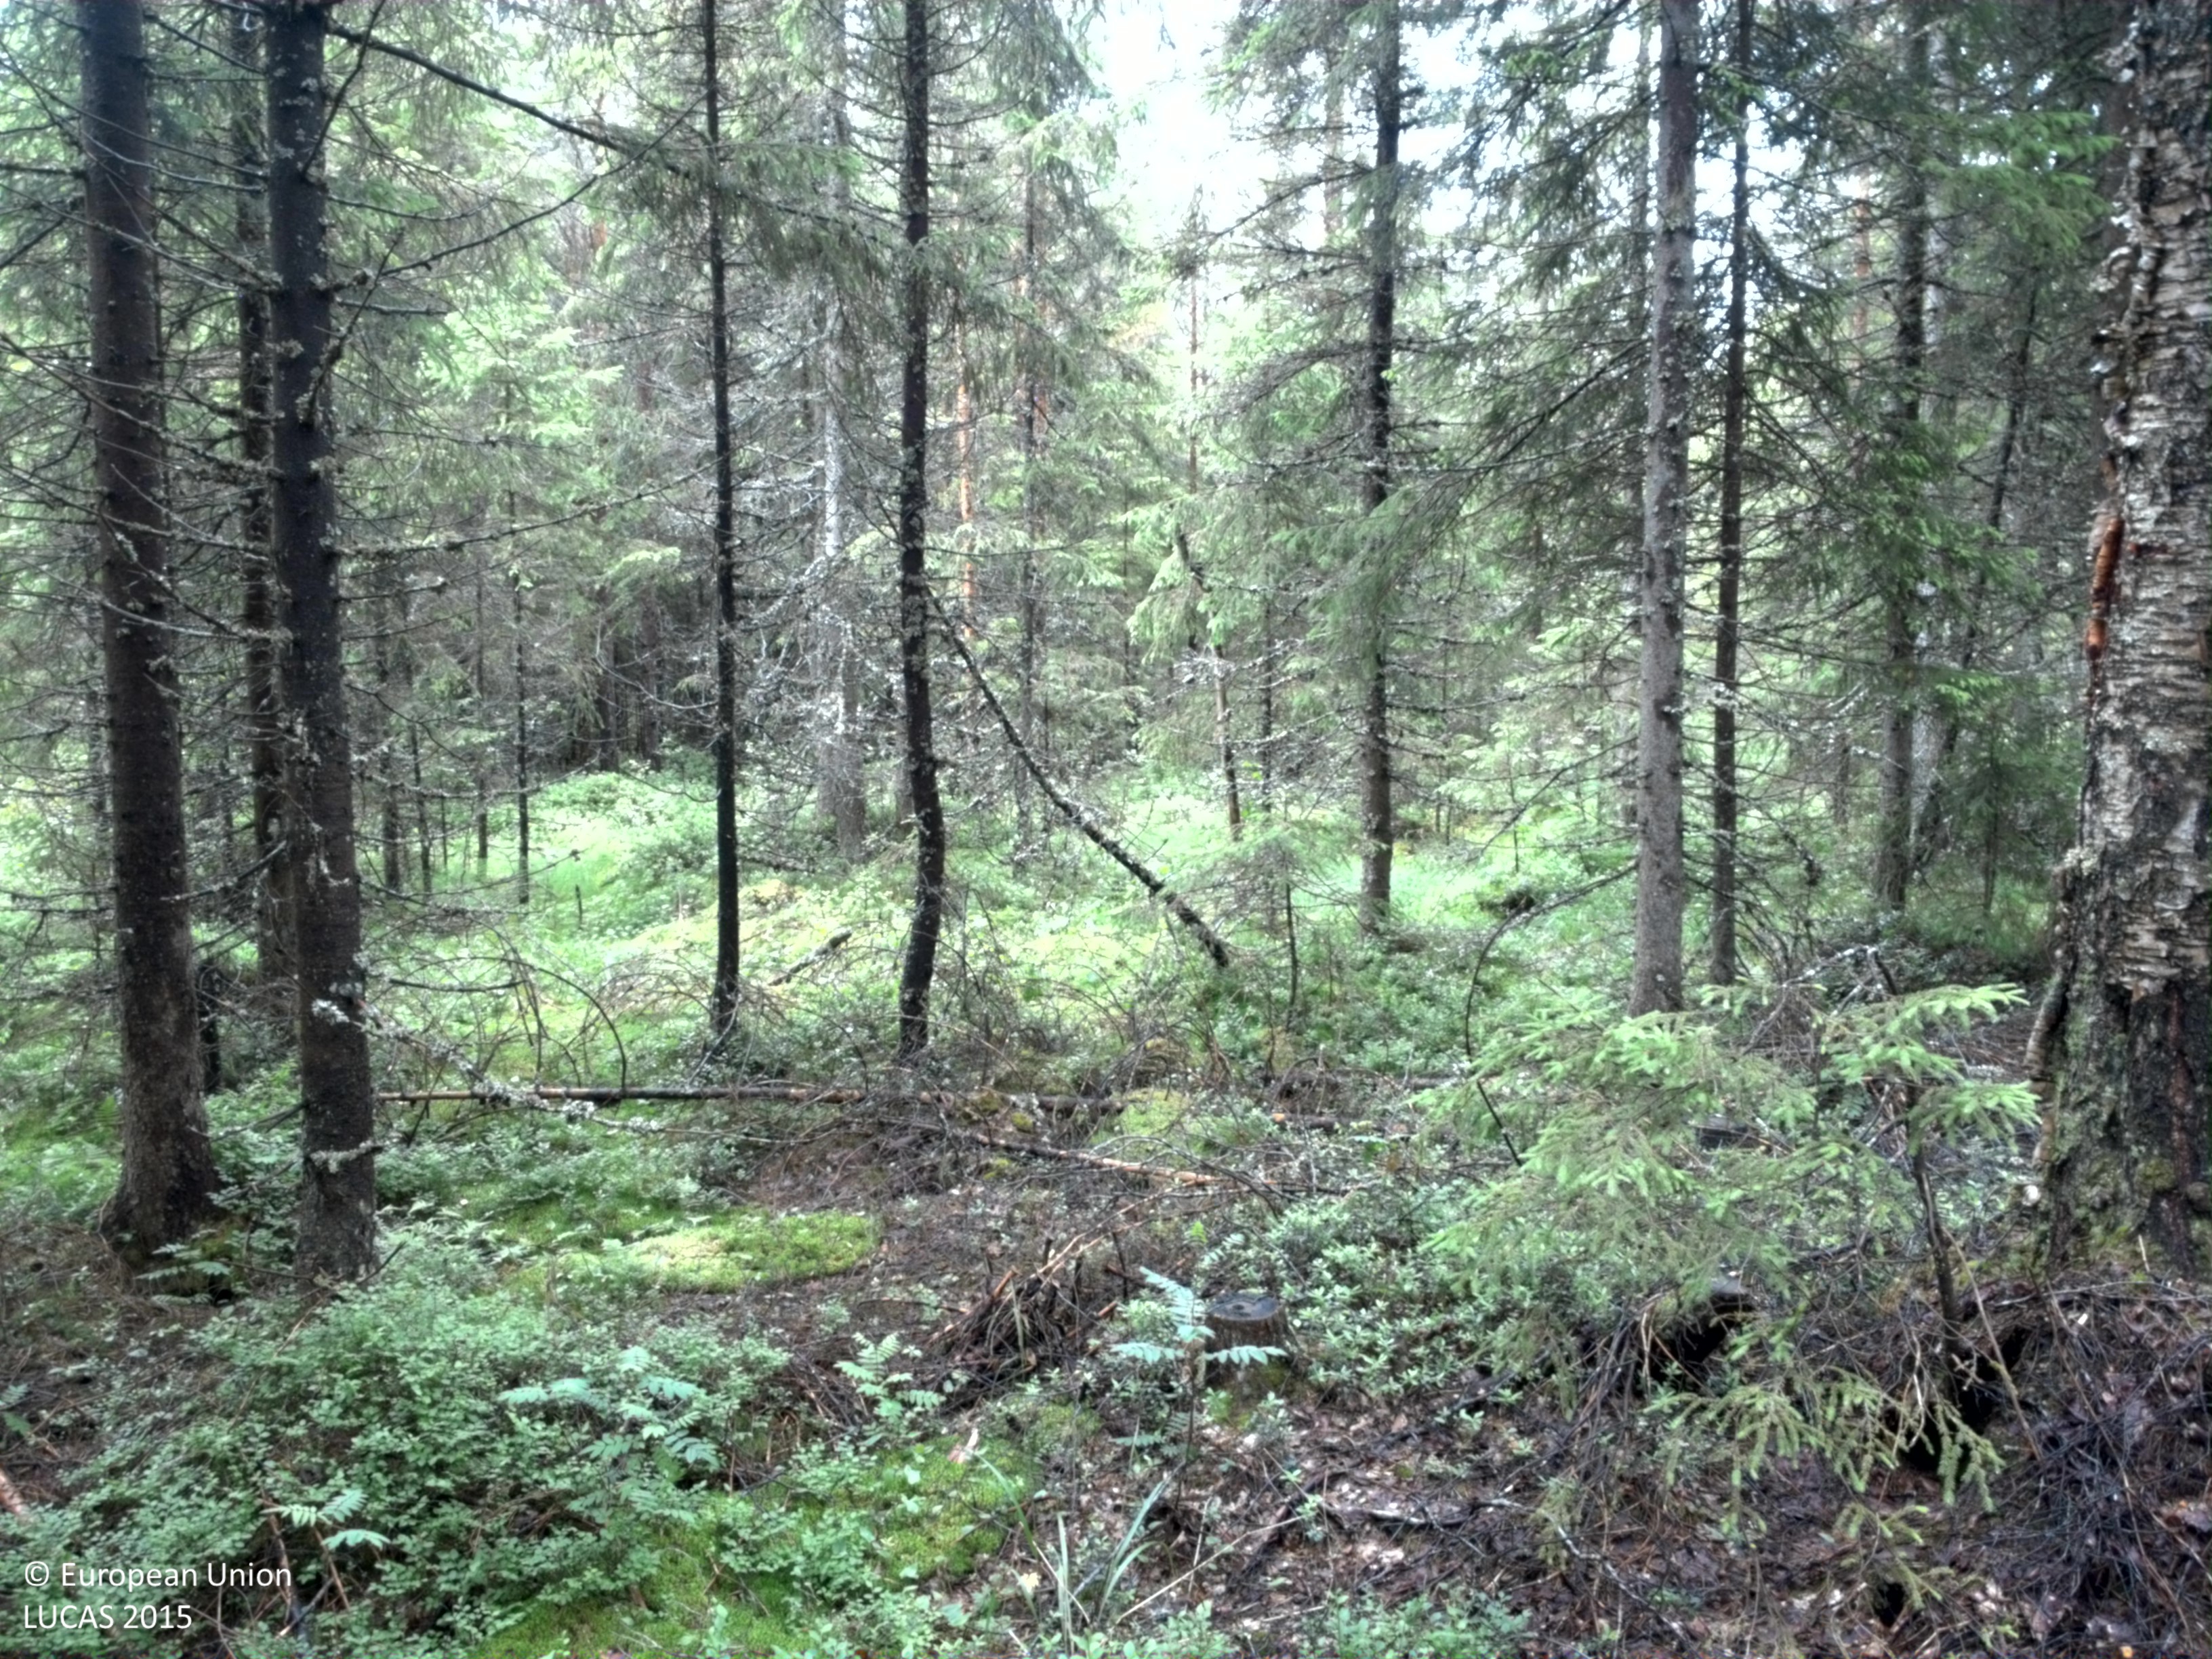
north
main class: Woodland
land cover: Spruce dominated coniferous woodland
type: boreal forest
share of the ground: 50 - 75 %
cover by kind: coniferous forest trees 55 %, shrubs 15 %, lichens and mosses 15 %, broadleaved forest trees 5 %, herbaceous plants 5 %
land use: Forestry
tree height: > 5 m
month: July
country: SE
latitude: 59.4903
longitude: 14.6706
